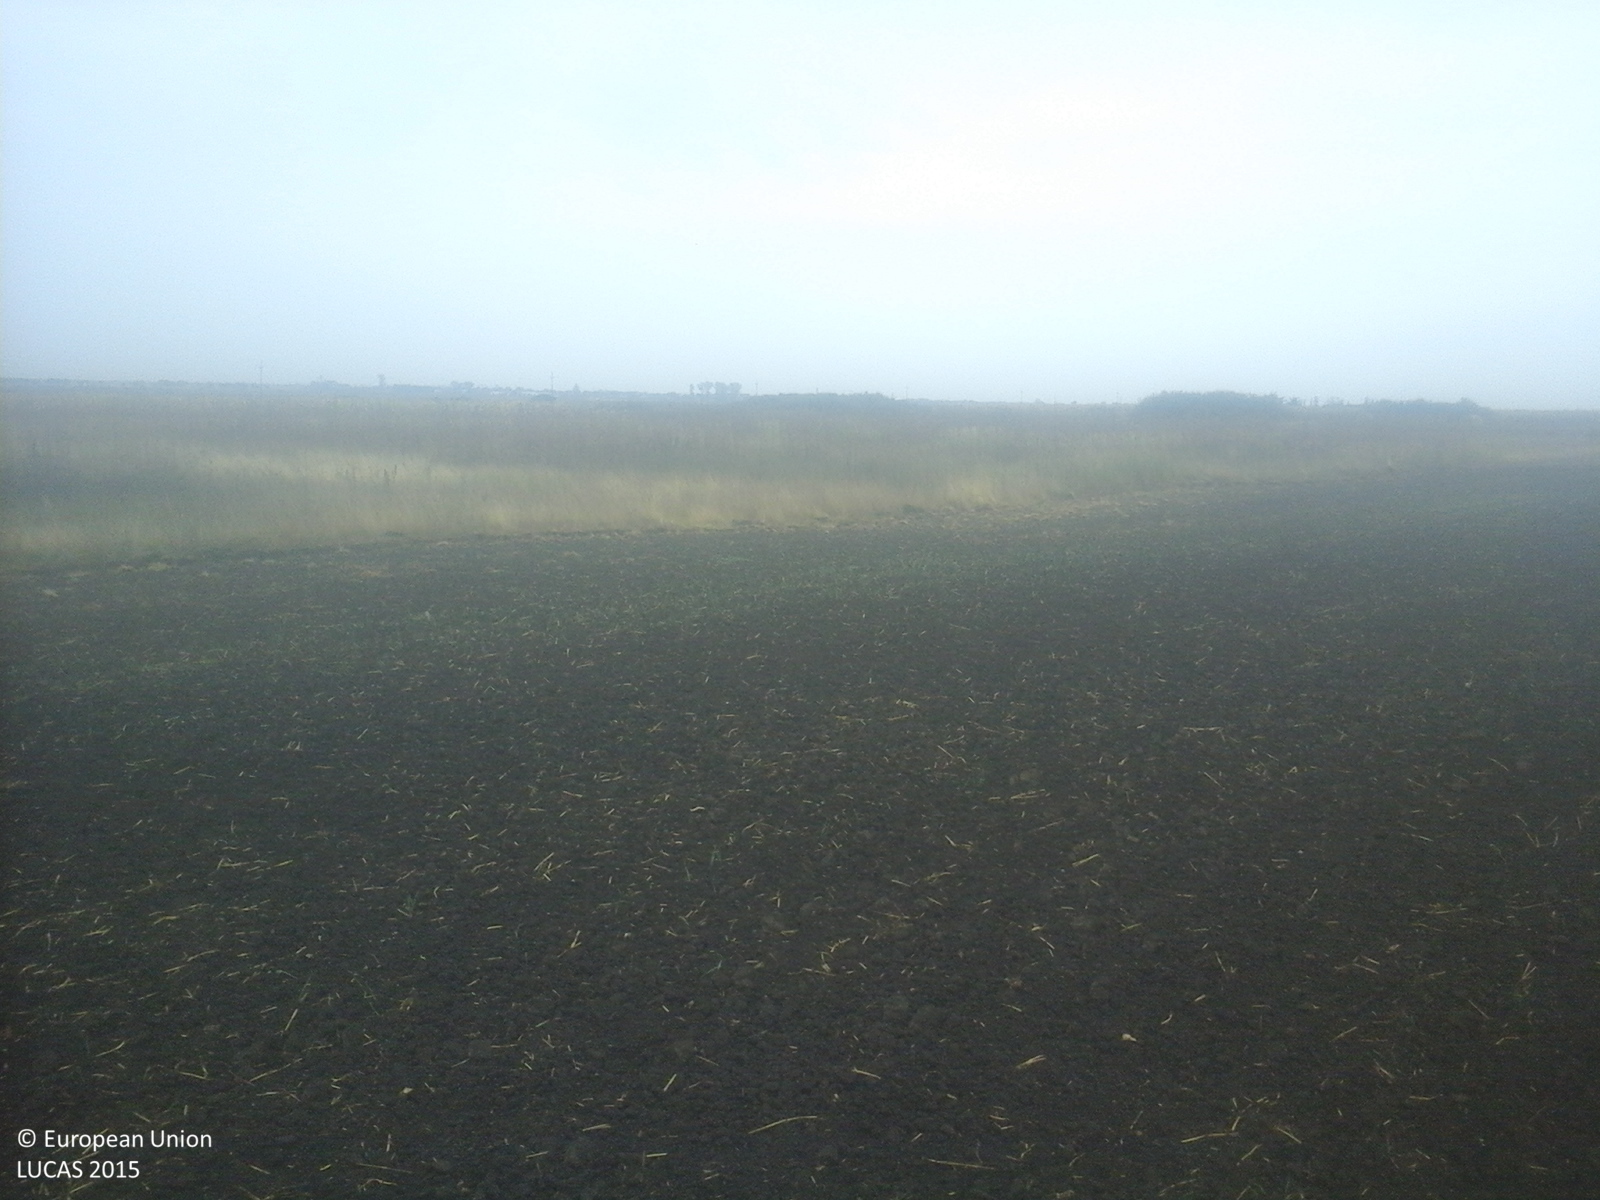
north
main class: Cropland
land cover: Common wheat
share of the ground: < 10 %
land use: Agriculture (excluding fallow land and kitchen gardens)
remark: Harvested field
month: September
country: RO
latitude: 47.5859
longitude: 22.4628
